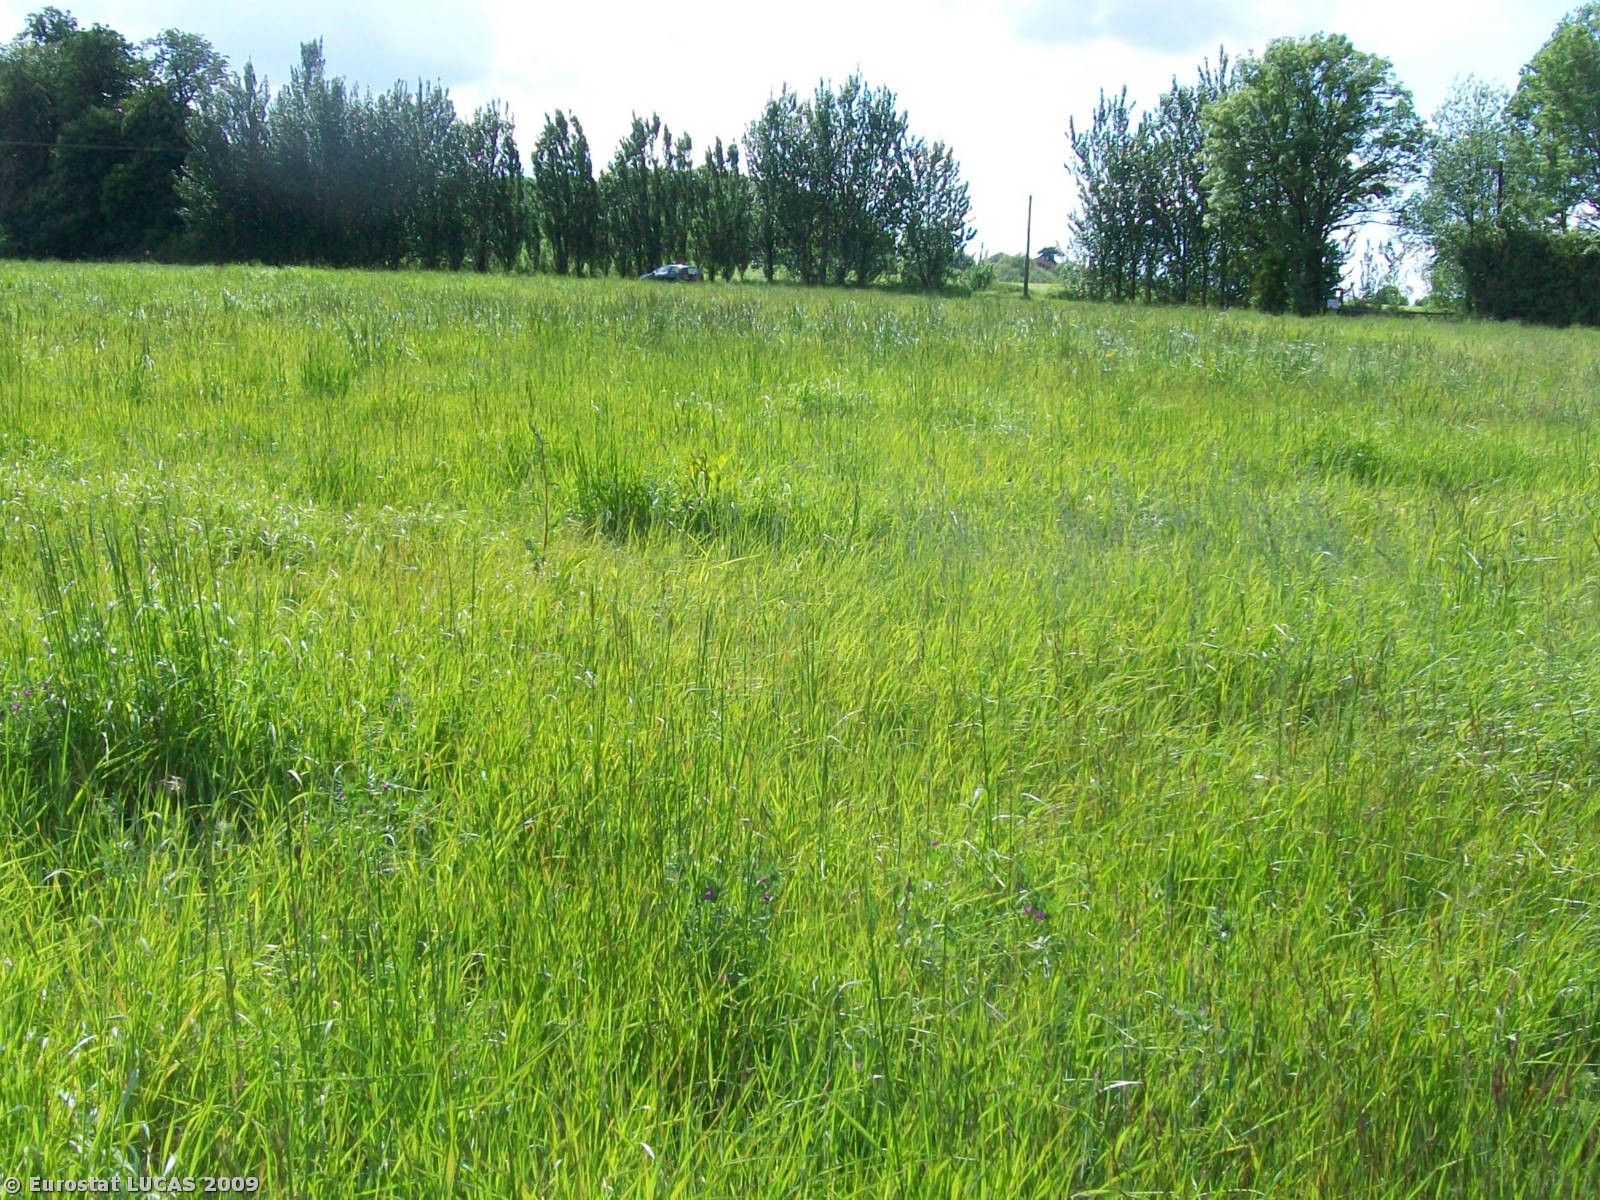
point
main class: Grassland
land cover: Grassland without tree/shrub cover
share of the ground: > 75 %
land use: Agriculture (excluding fallow land and kitchen gardens)
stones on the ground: < 10 %
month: May
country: GB
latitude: 51.1836
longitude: 0.3135
